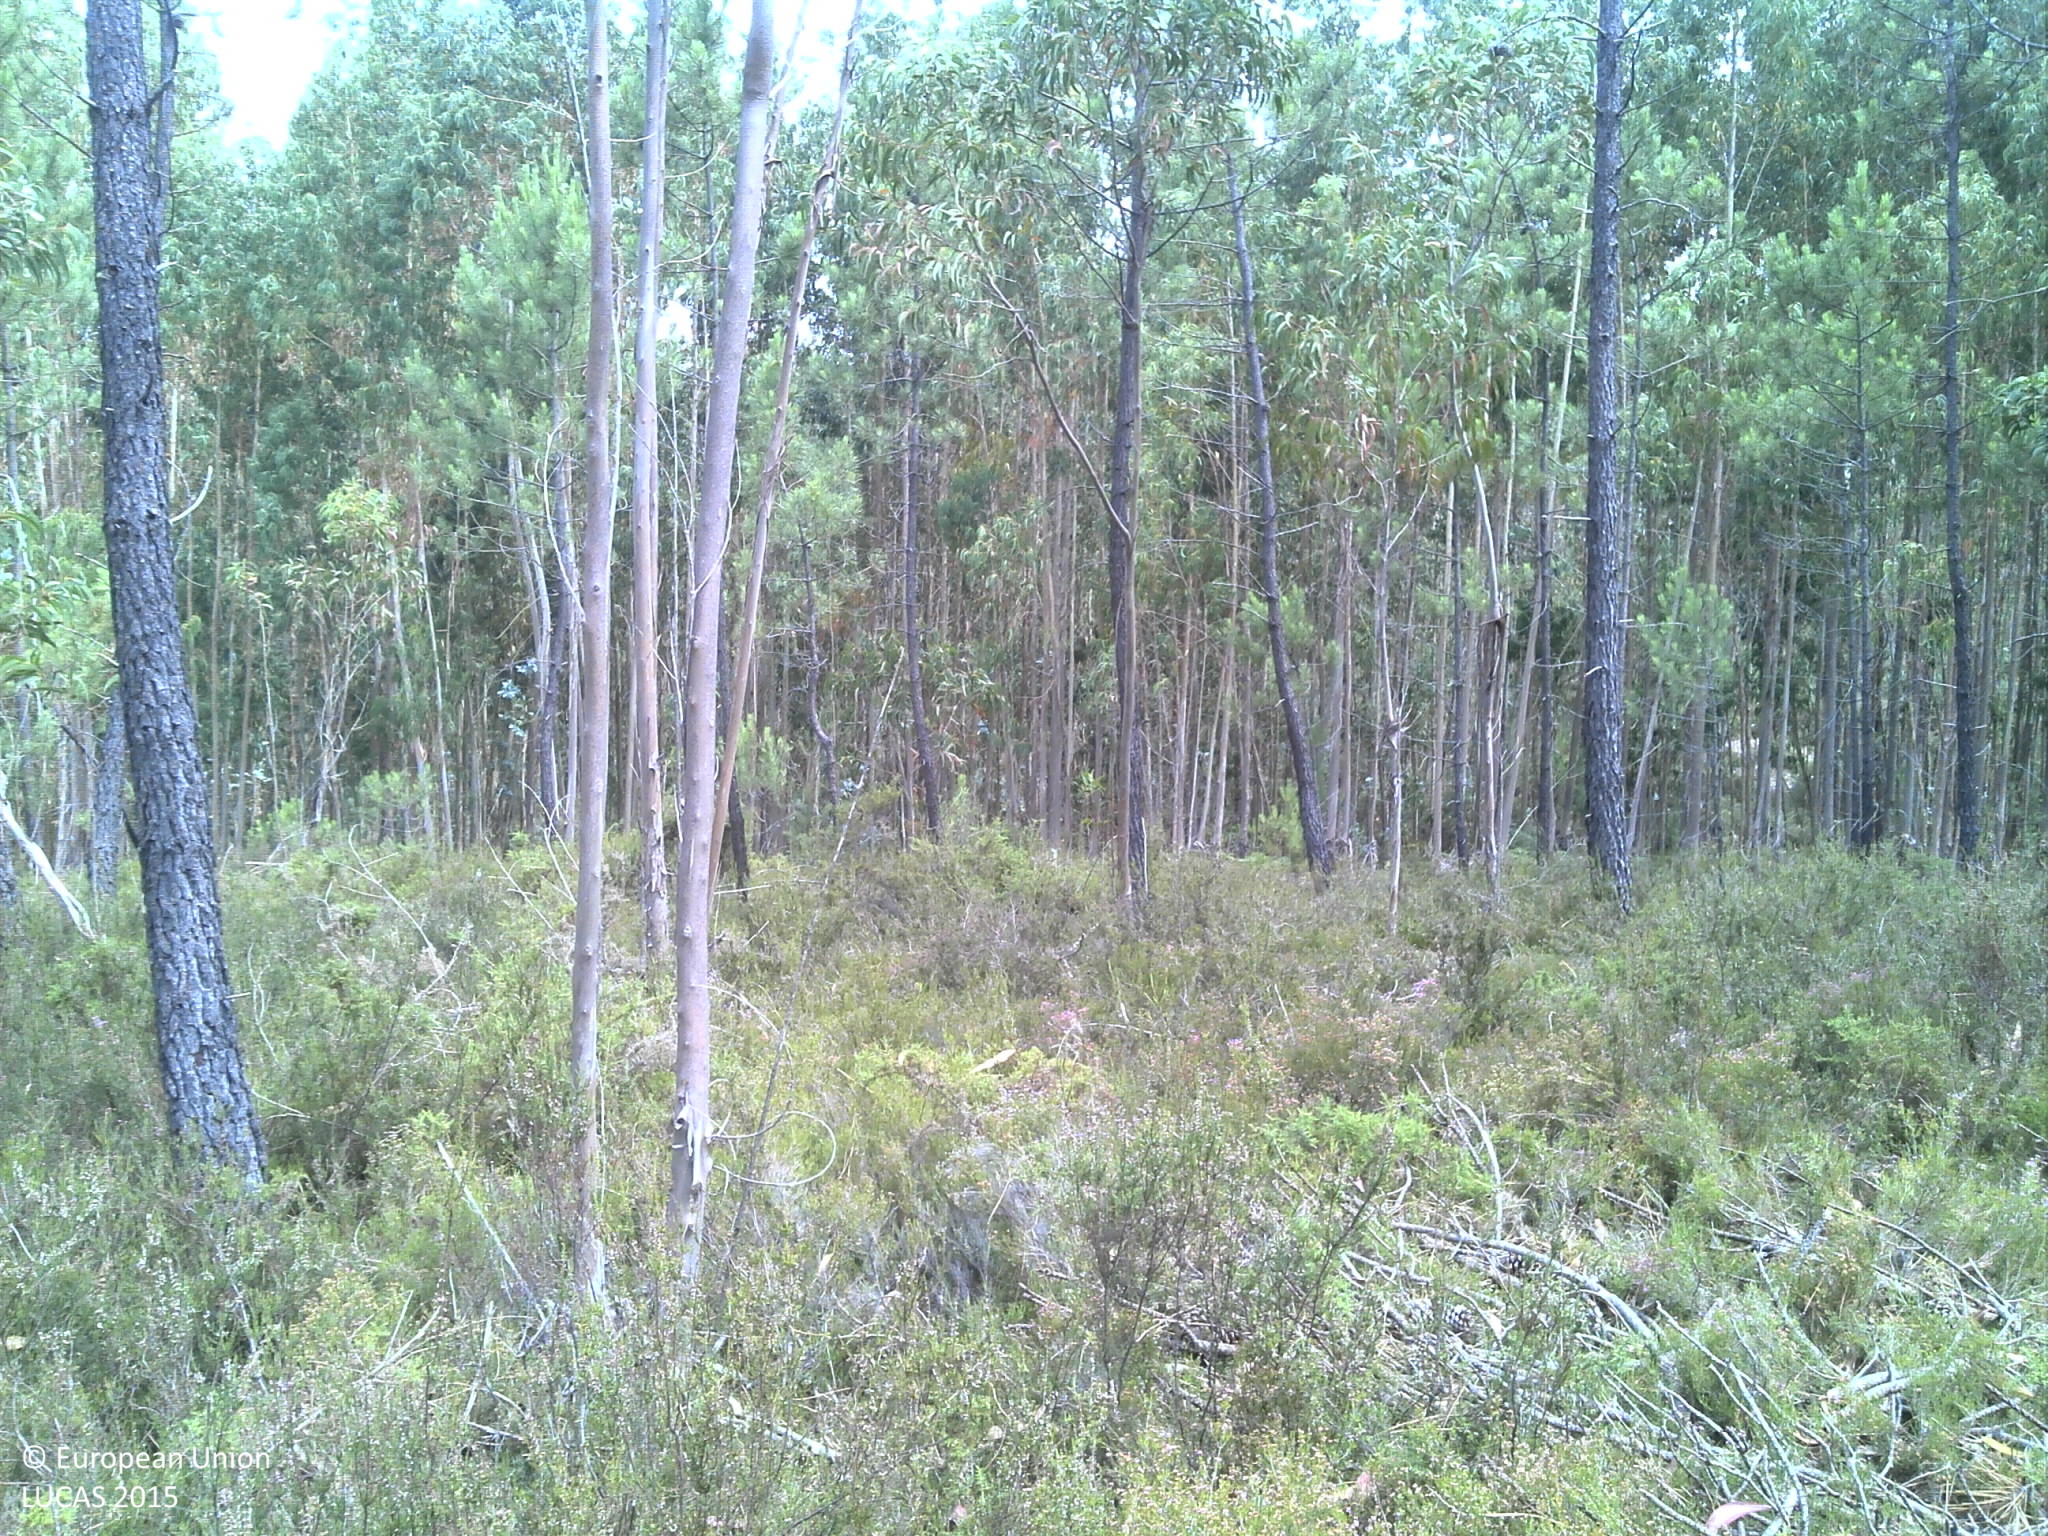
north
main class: Woodland
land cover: Pine dominated coniferous woodland
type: coniferous forest of the mediterranean region
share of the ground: 50 - 75 %
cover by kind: coniferous forest trees 60 %, shrubs 35 %, unconsolidated bare surface 5 %
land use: Forestry
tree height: > 5 m
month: June
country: PT
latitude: 40.4740
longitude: -8.3812
